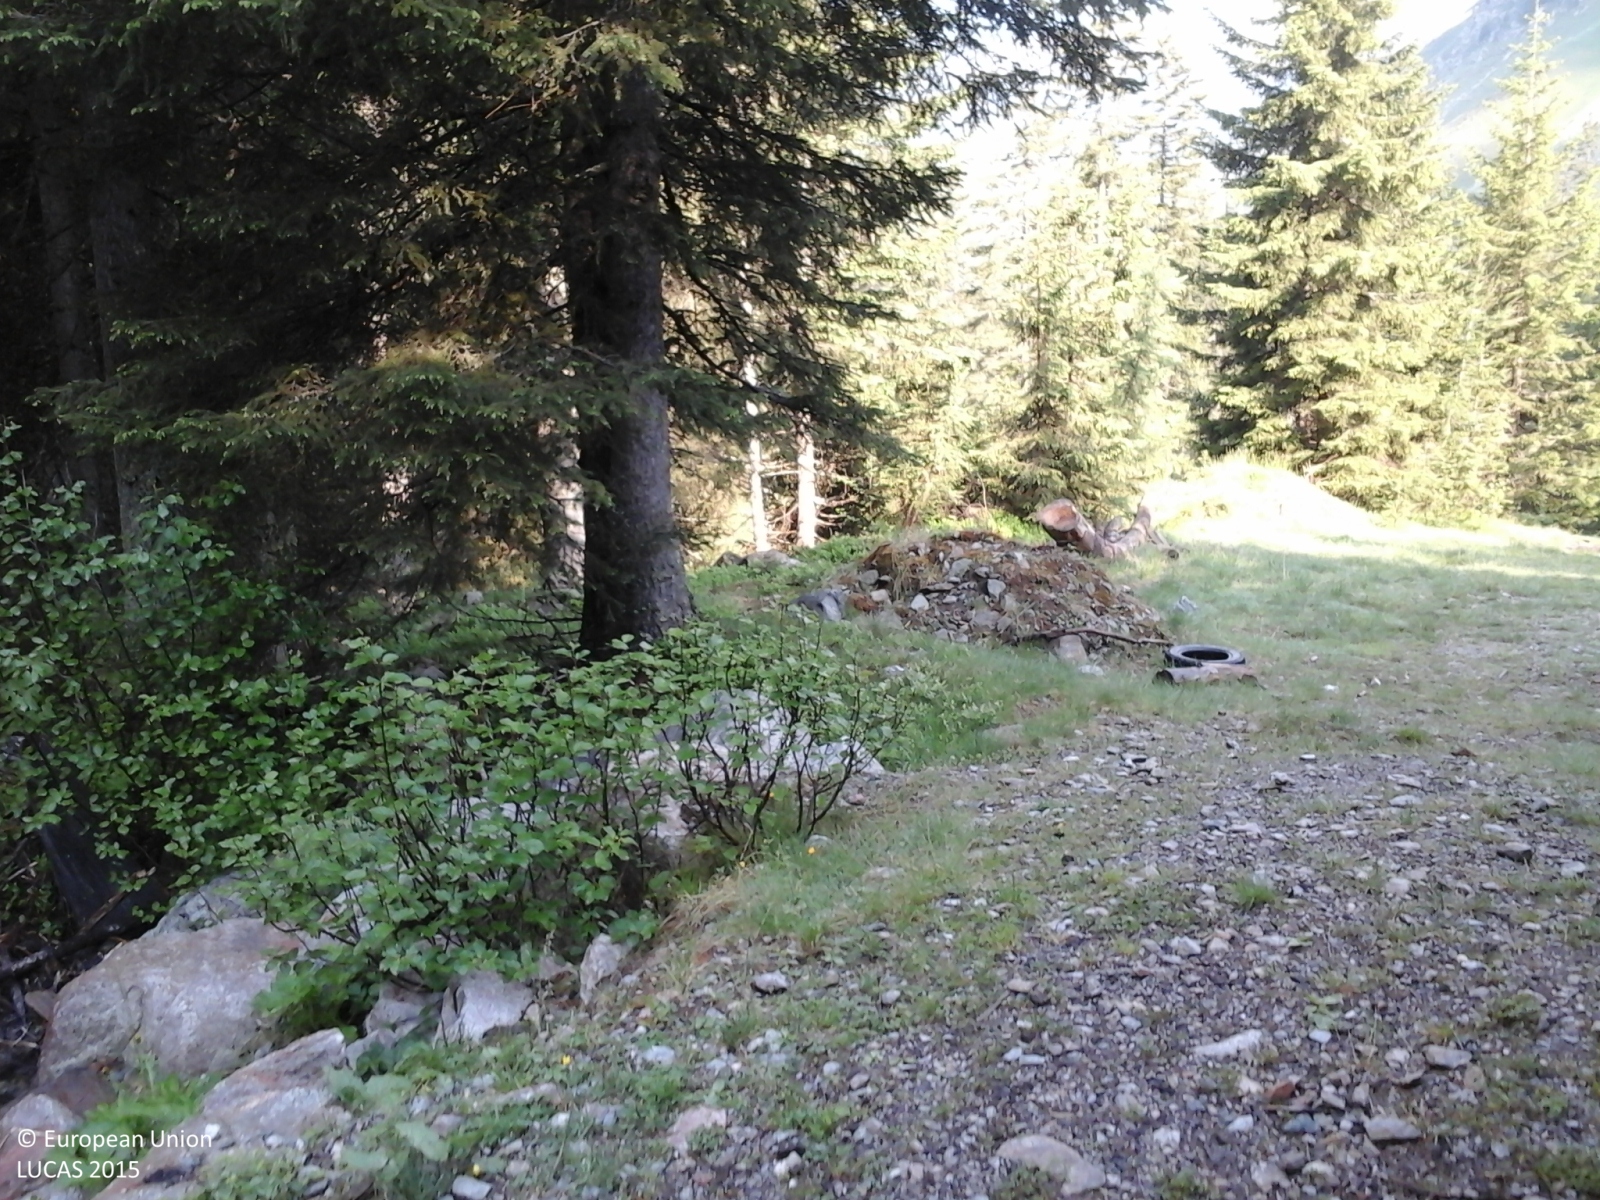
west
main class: Woodland
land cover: Spruce dominated coniferous woodland
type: alpine coniferous forest
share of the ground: > 75 %
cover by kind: coniferous forest trees 100 %
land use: Forestry
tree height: > 5 m
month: June
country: IT
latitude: 46.7917
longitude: 11.4526
